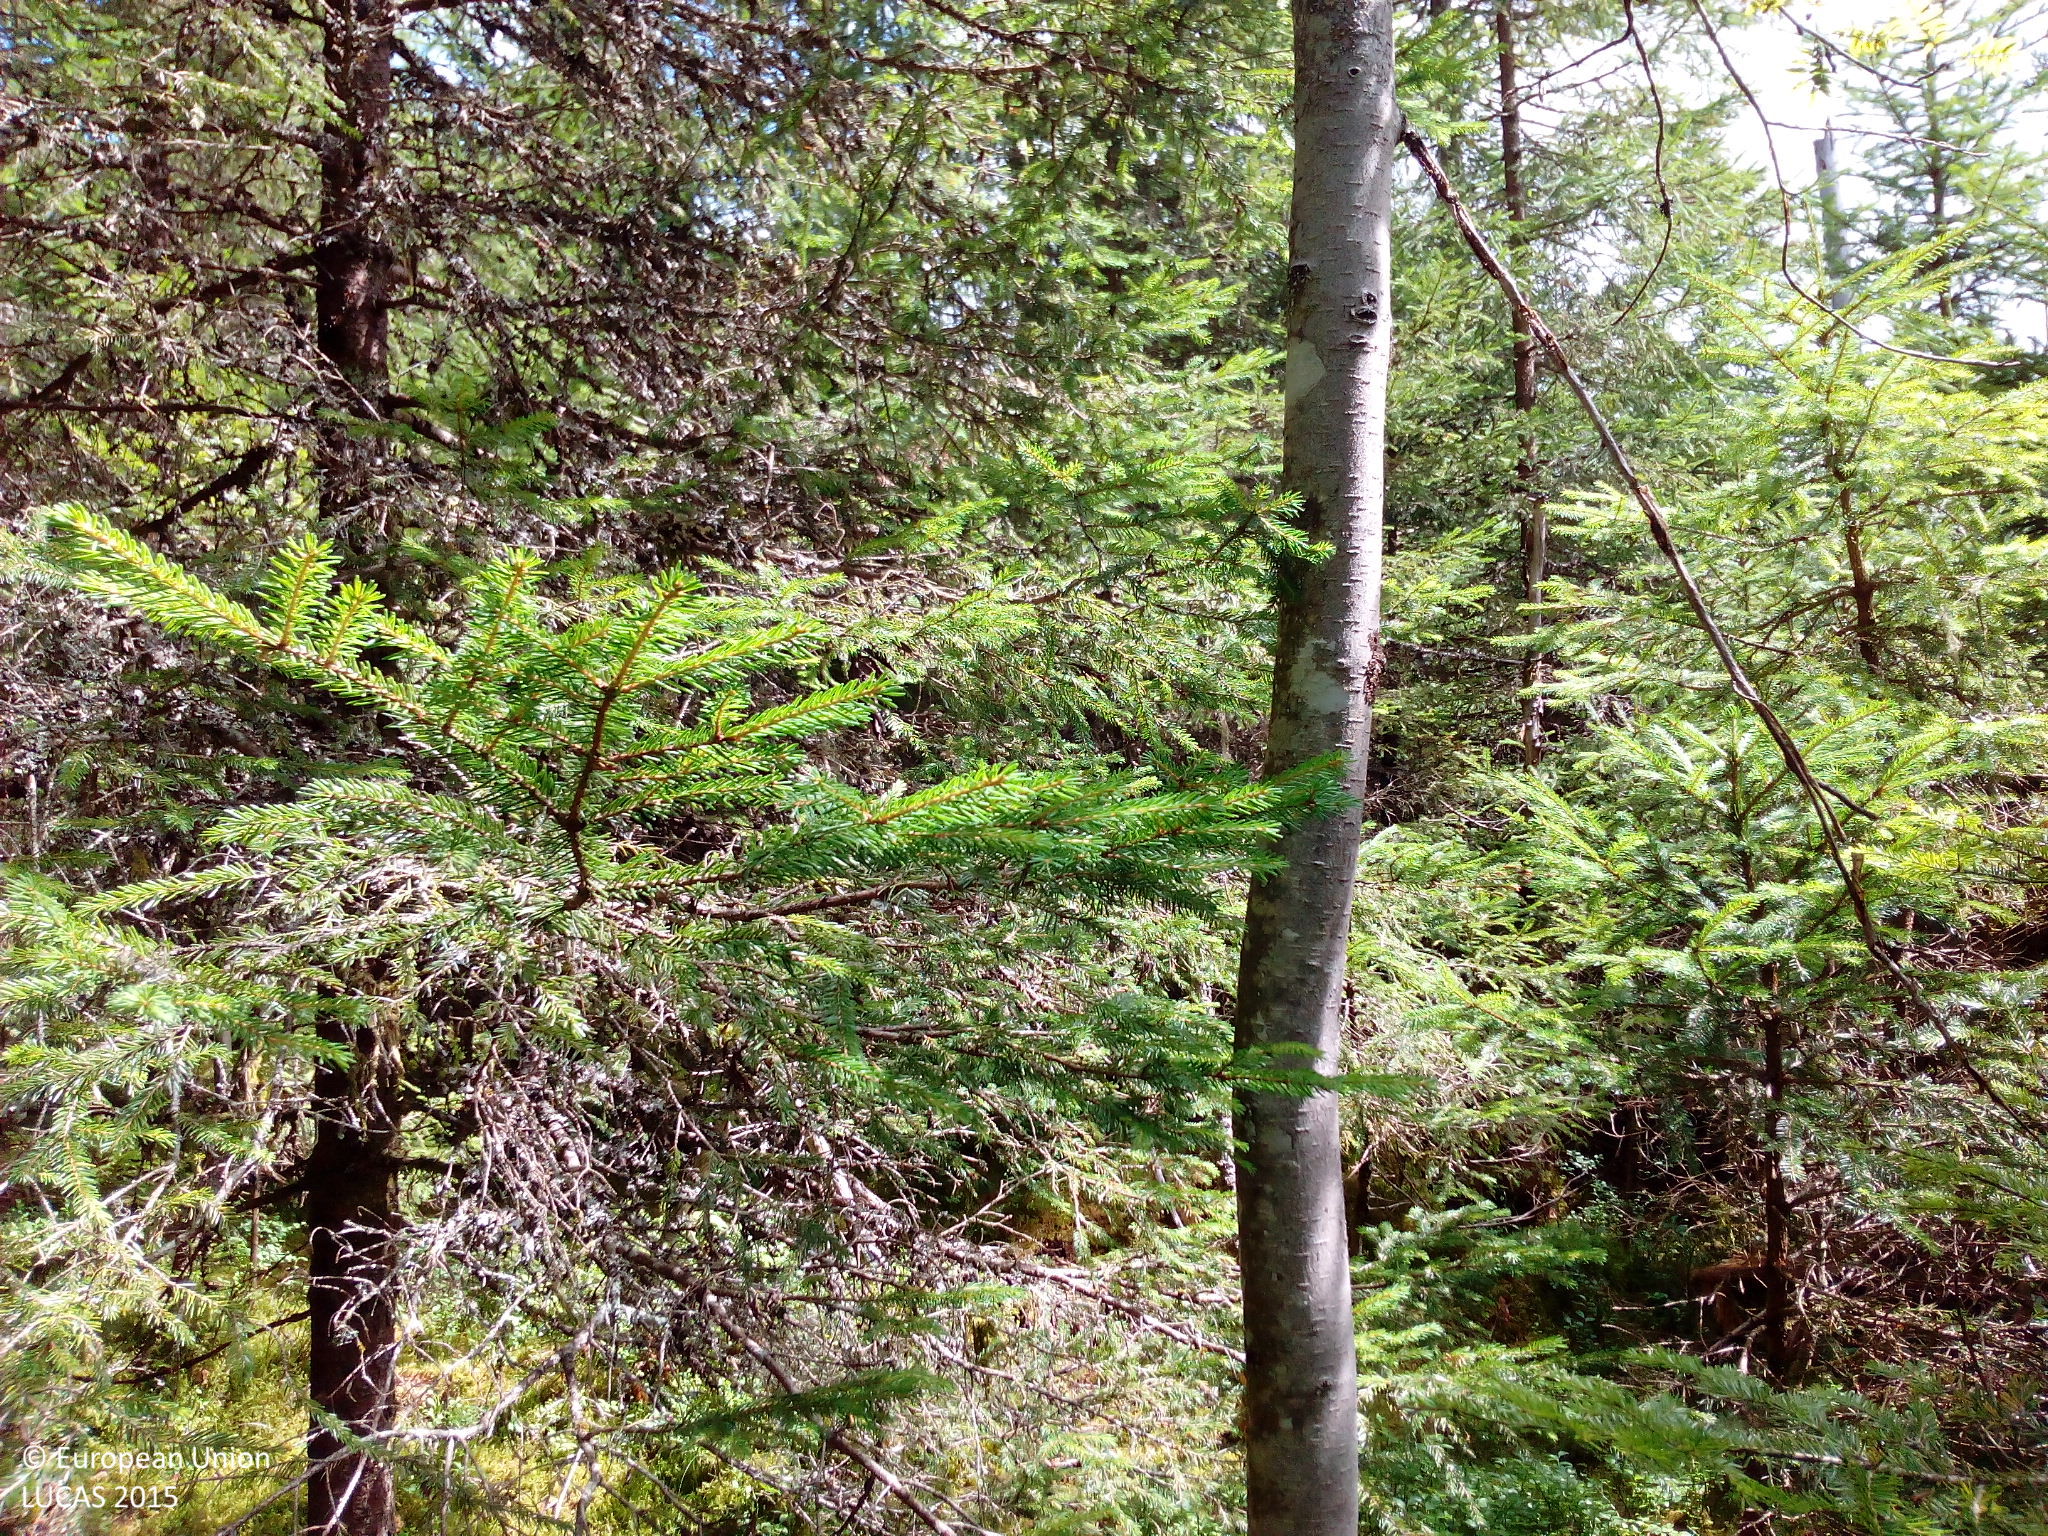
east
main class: Woodland
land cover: Spruce dominated coniferous woodland
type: hemiboreal forest and nemoral coniferous forest and mixed broadleaved-coniferous forest
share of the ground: > 75 %
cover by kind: coniferous forest trees 80 %, shrubs 10 %, lichens and mosses 10 %
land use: Semi-natural and natural areas not in use
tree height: > 5 m
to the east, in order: Spruce dominated coniferous woodland; Shrubland with sparse tree cover; Spruce dominated coniferous woodland; Shrubland with sparse tree cover; Ditches and canals; Tracks; Ditches and canals; Spruce dominated mixed woodland; Grass margins; Paved roads, cycling and walking lanes; Tracks
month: August
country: DE
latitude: 47.7768
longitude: 8.1996
